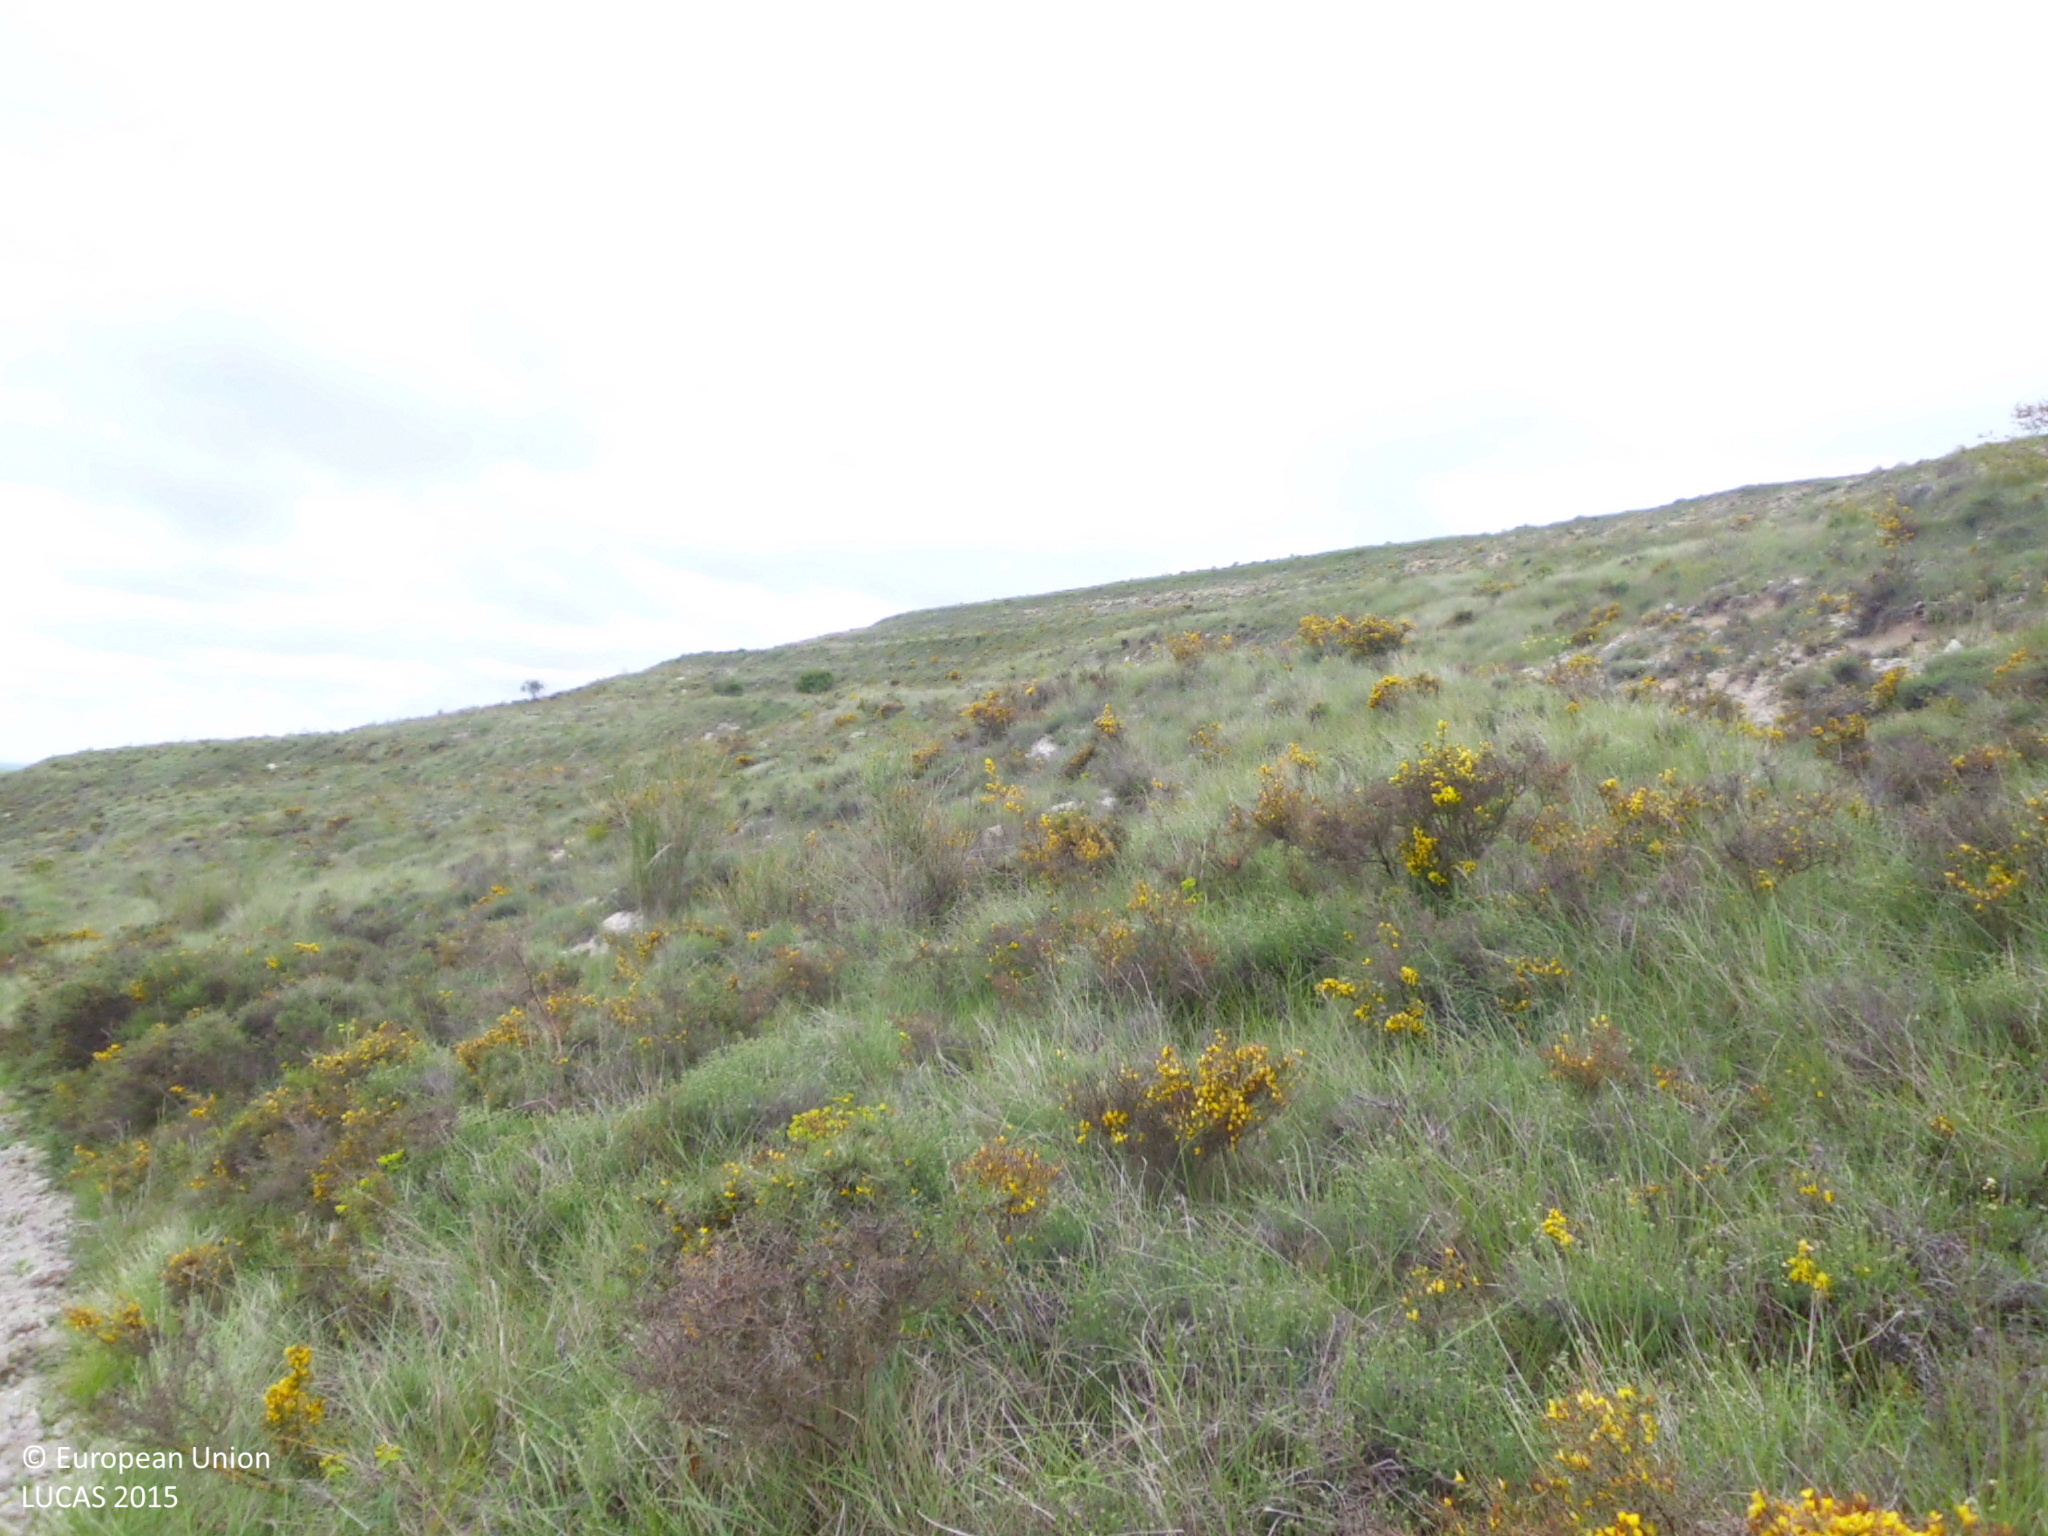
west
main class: Shrubland
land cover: Shrubland without tree cover
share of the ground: > 75 %
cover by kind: shrubs 60 %, herbaceous plants 40 %
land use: Semi-natural and natural areas not in use
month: May
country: ES
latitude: 42.5242
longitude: -3.9562
